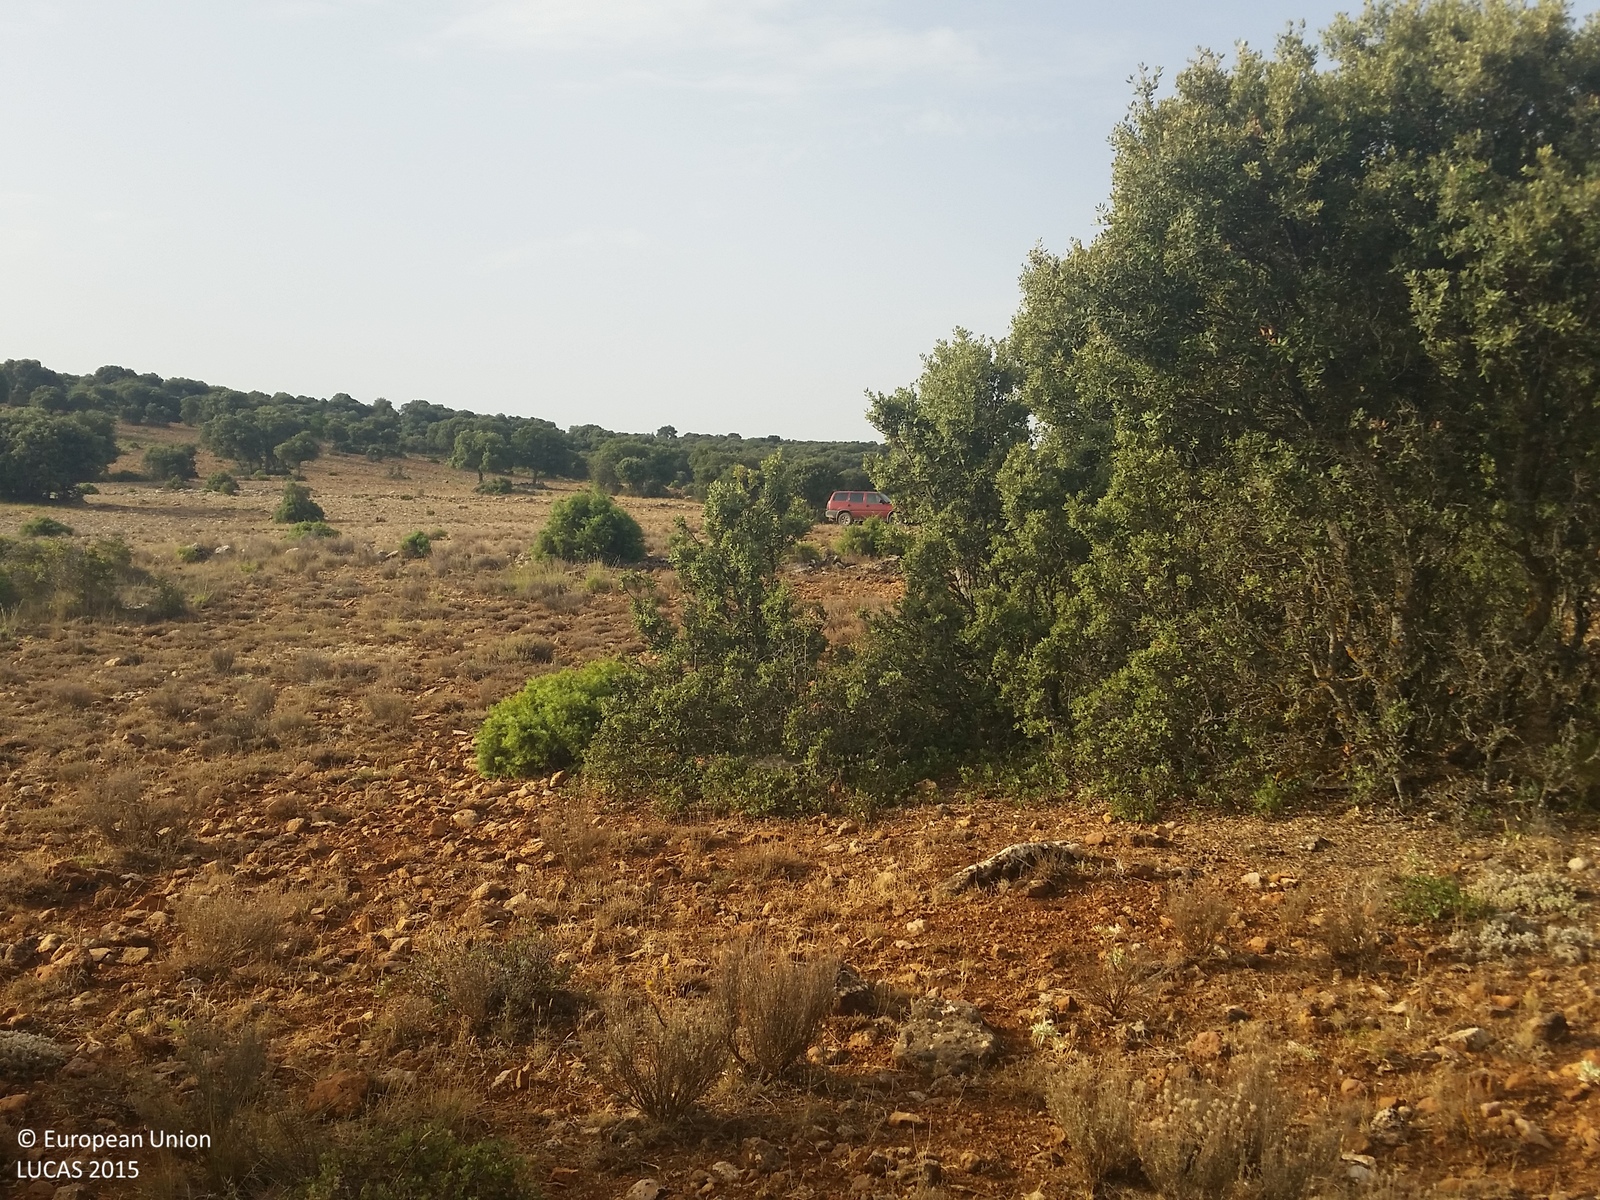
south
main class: Woodland
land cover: Broadleaved woodland
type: broadleaved evergreen forest
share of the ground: 25 - 50 %
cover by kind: shrubs 40 %, consolidated bare surface 30 %, broadleaved forest trees 25 %, herbaceous plants 5 %
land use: Semi-natural and natural areas not in use
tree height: < 5 m
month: August
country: ES
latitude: 38.6514
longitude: -2.4216
